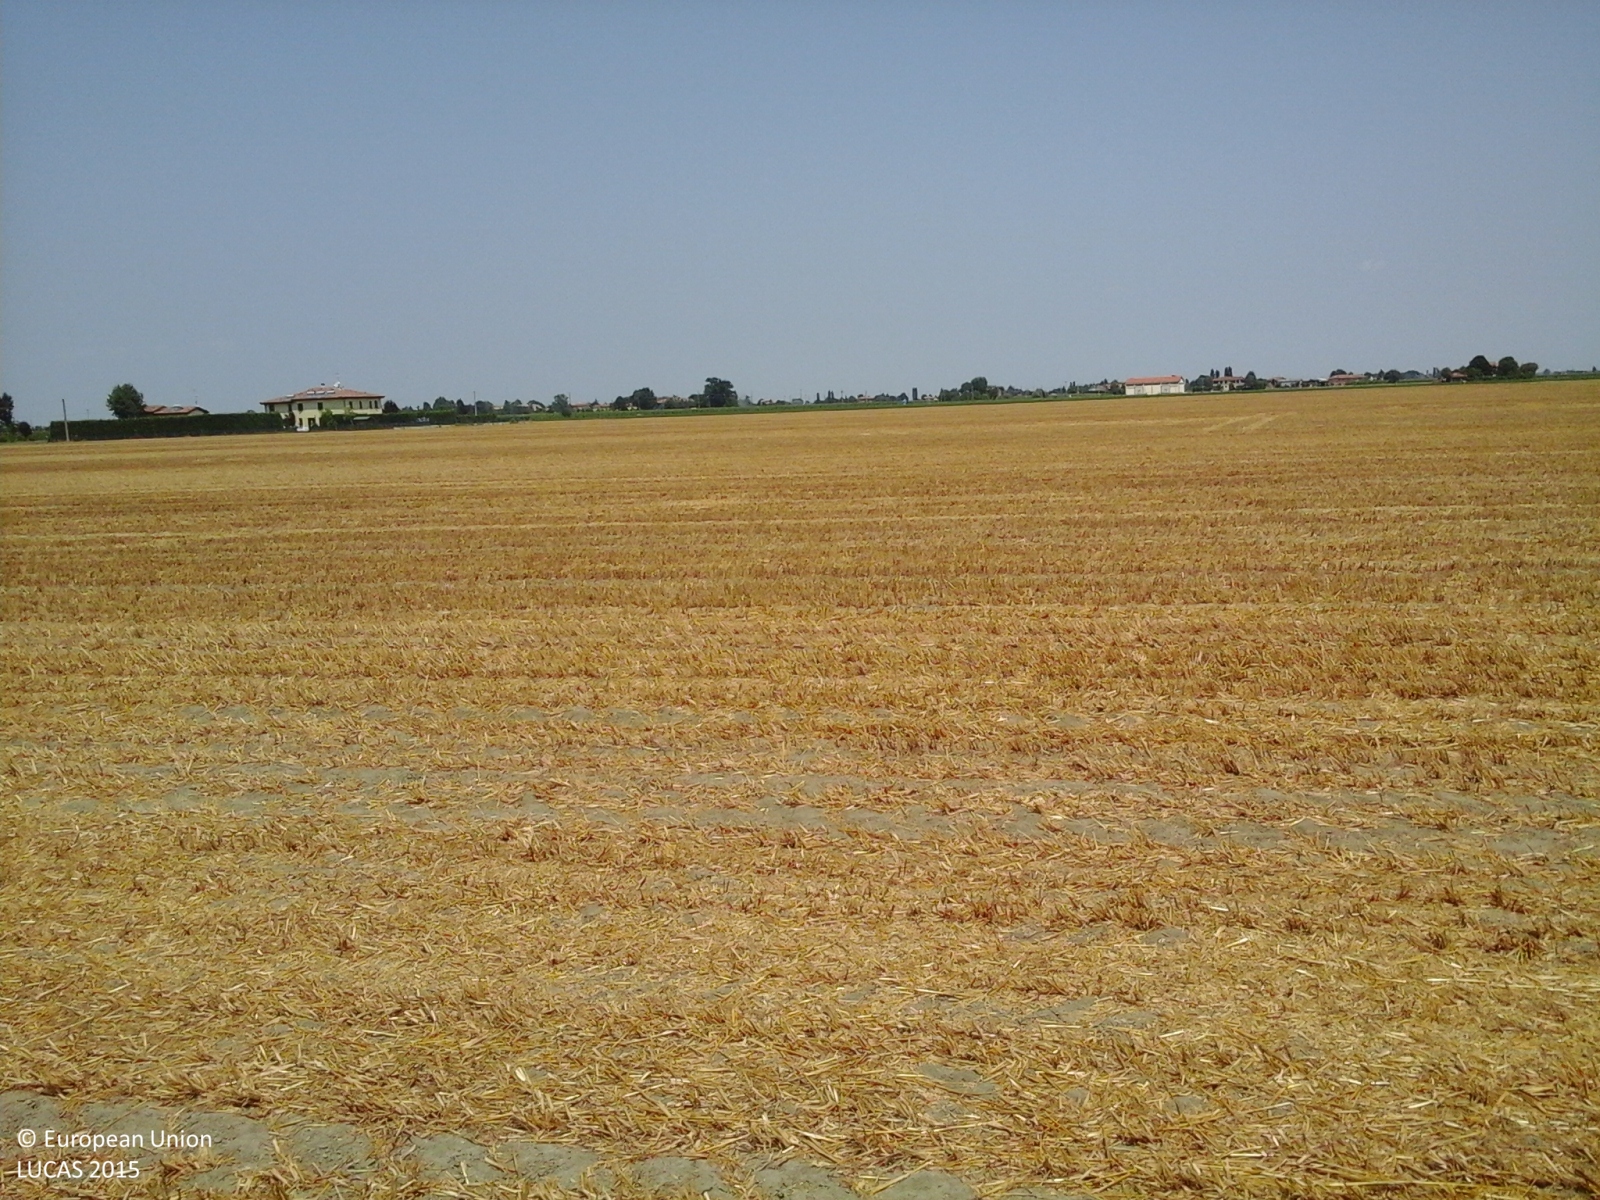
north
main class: Cropland
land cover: Common wheat
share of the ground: > 75 %
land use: Agriculture (excluding fallow land and kitchen gardens)
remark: Harvested field
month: July
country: IT
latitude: 44.4450
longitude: 11.6926
